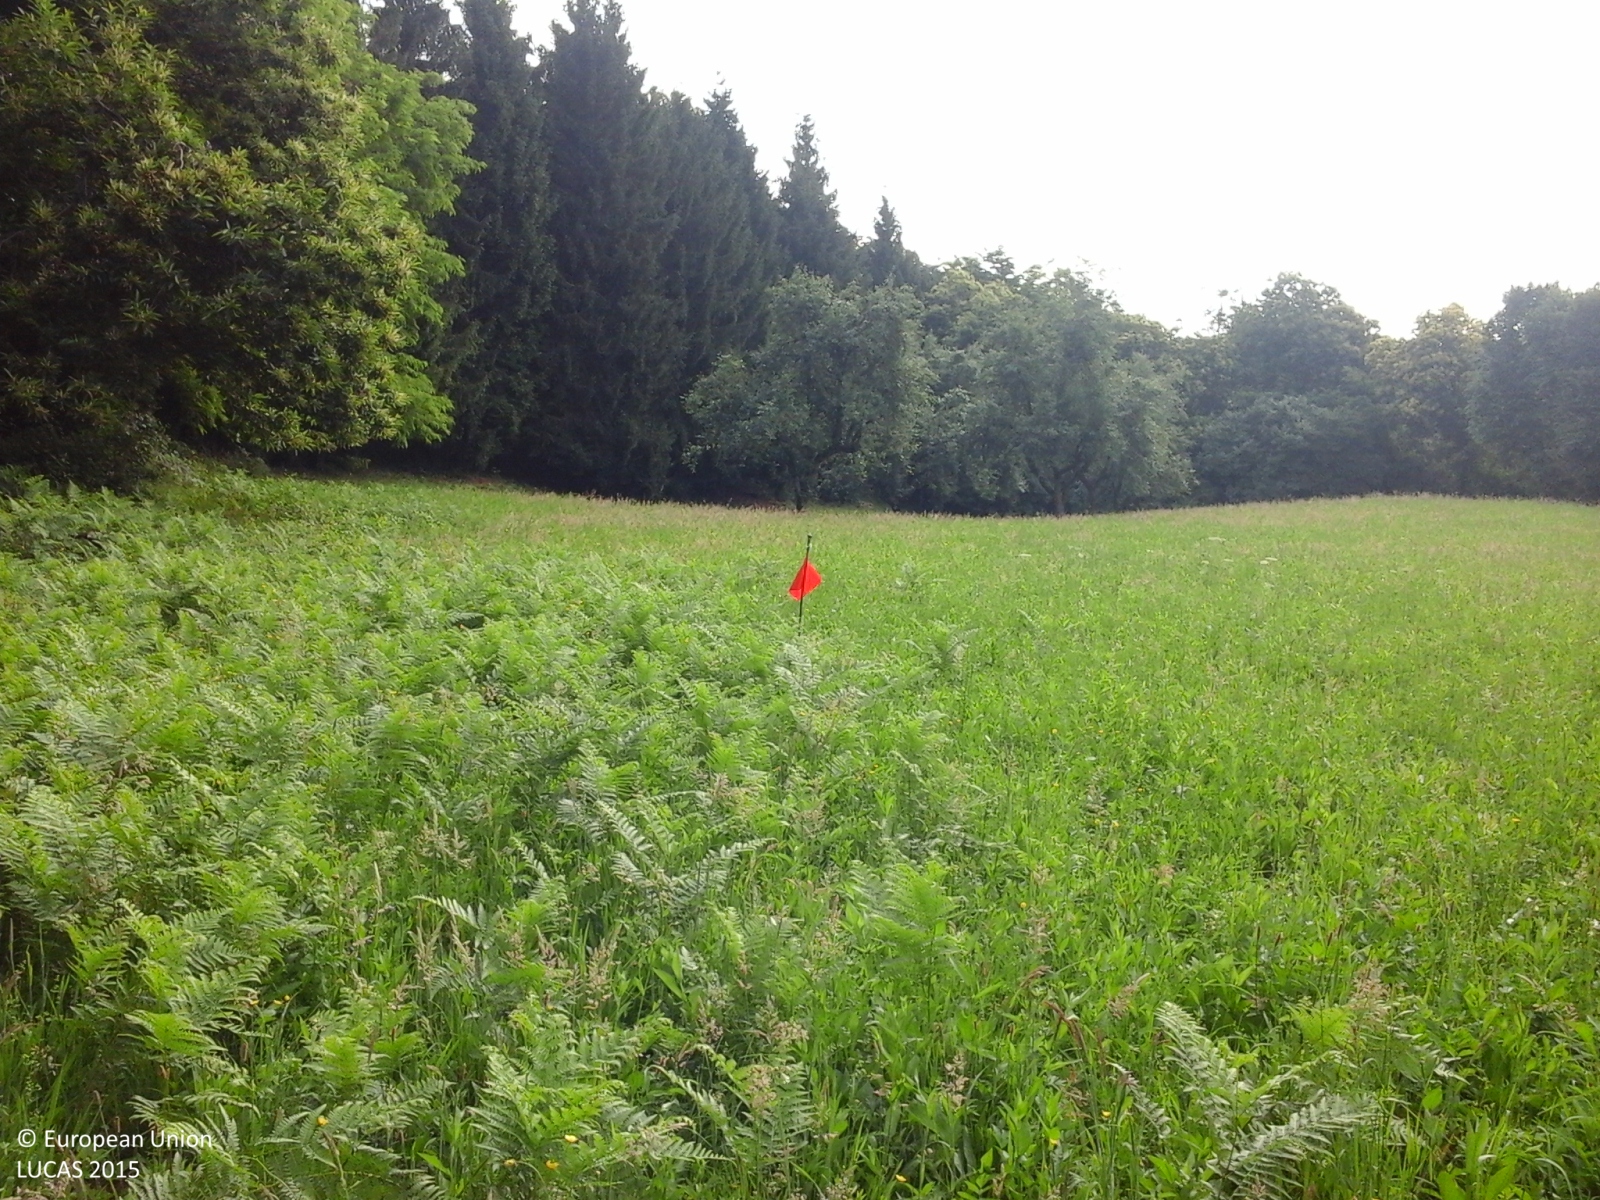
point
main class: Grassland
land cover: Grassland without tree/shrub cover
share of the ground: > 75 %
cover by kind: herbaceous plants 100 %
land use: Agriculture (excluding fallow land and kitchen gardens)
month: June
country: IT
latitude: 45.6486
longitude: 10.0640
